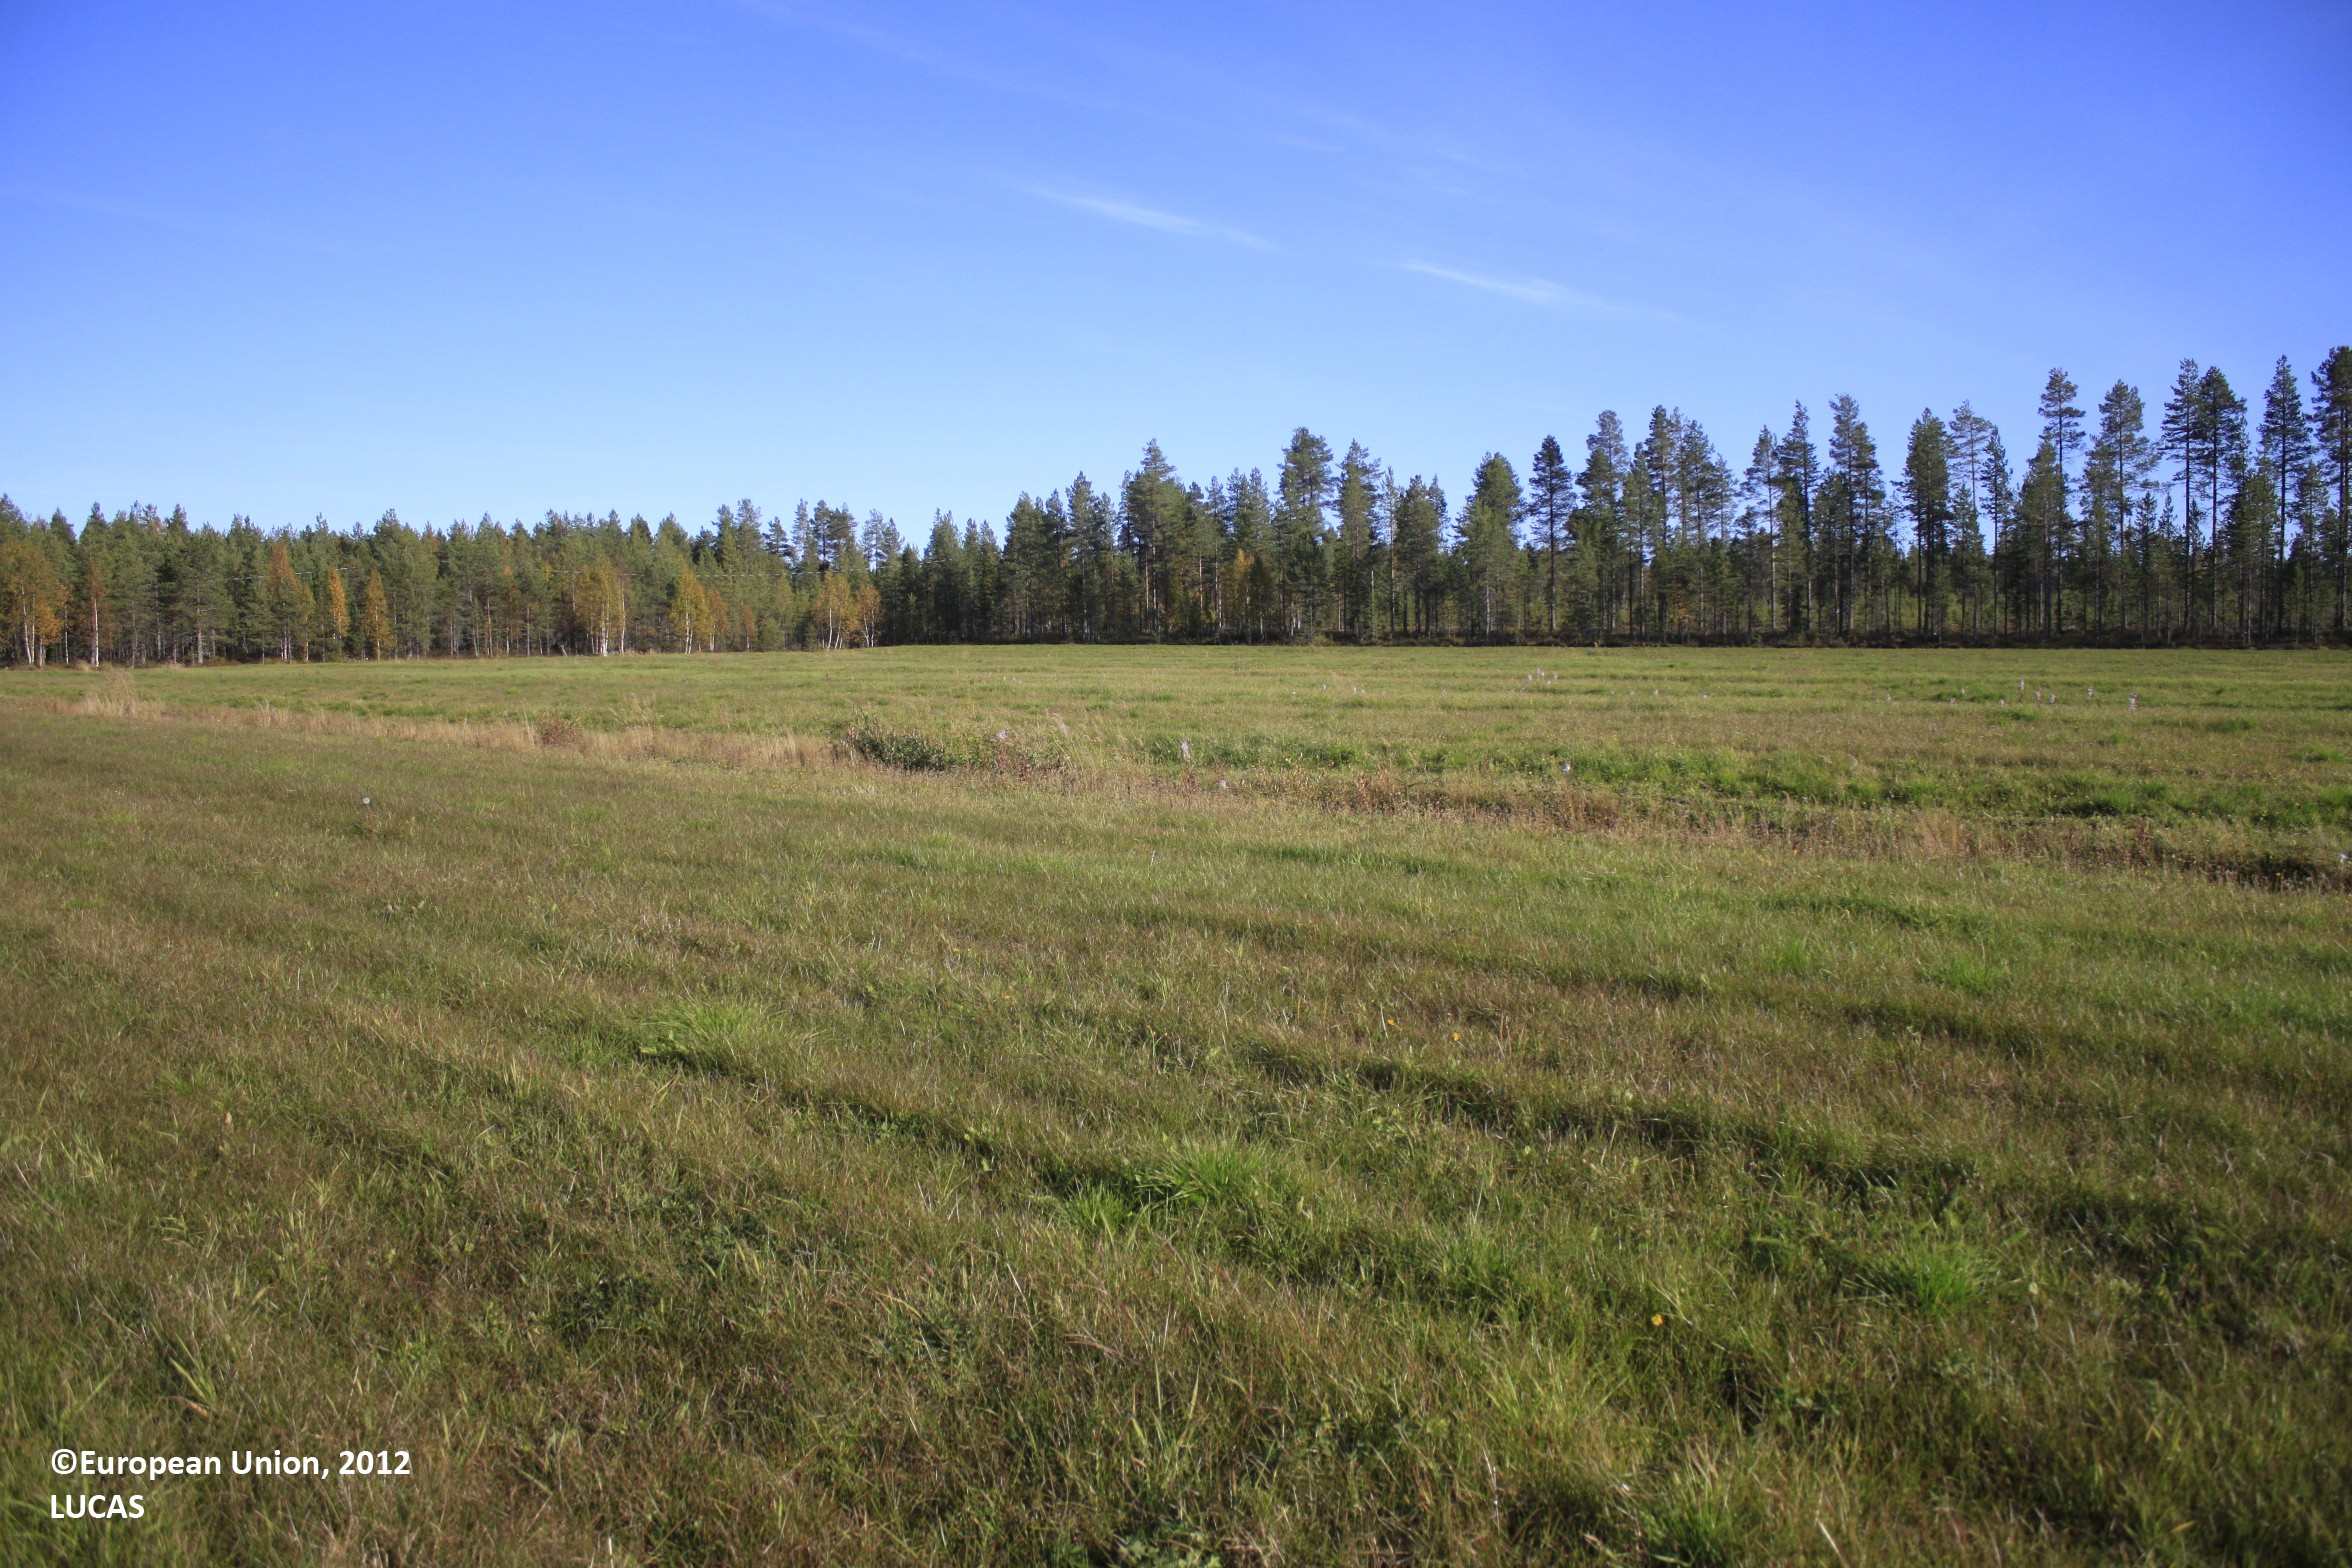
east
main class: Grassland
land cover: Grassland without tree/shrub cover
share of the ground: > 75 %
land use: Fallow land
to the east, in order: Grassland without tree/shrub cover; Ditches and canals; Grassland without tree/shrub cover; Ditches and canals; Grassland without tree/shrub cover; Ditches and canals; Tracks; Ditches and canals; Pine dominated coniferous woodland; Electric lines; Pine dominated coniferous woodland; Ditches and canals; Pine dominated coniferous woodland; Ditches and canals; Pine dominated coniferous woodland; Ditches and canals; Pine dominated coniferous woodland; Ditches and canals; Pine dominated coniferous woodland
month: September
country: FI
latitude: 65.8548
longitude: 26.7763
